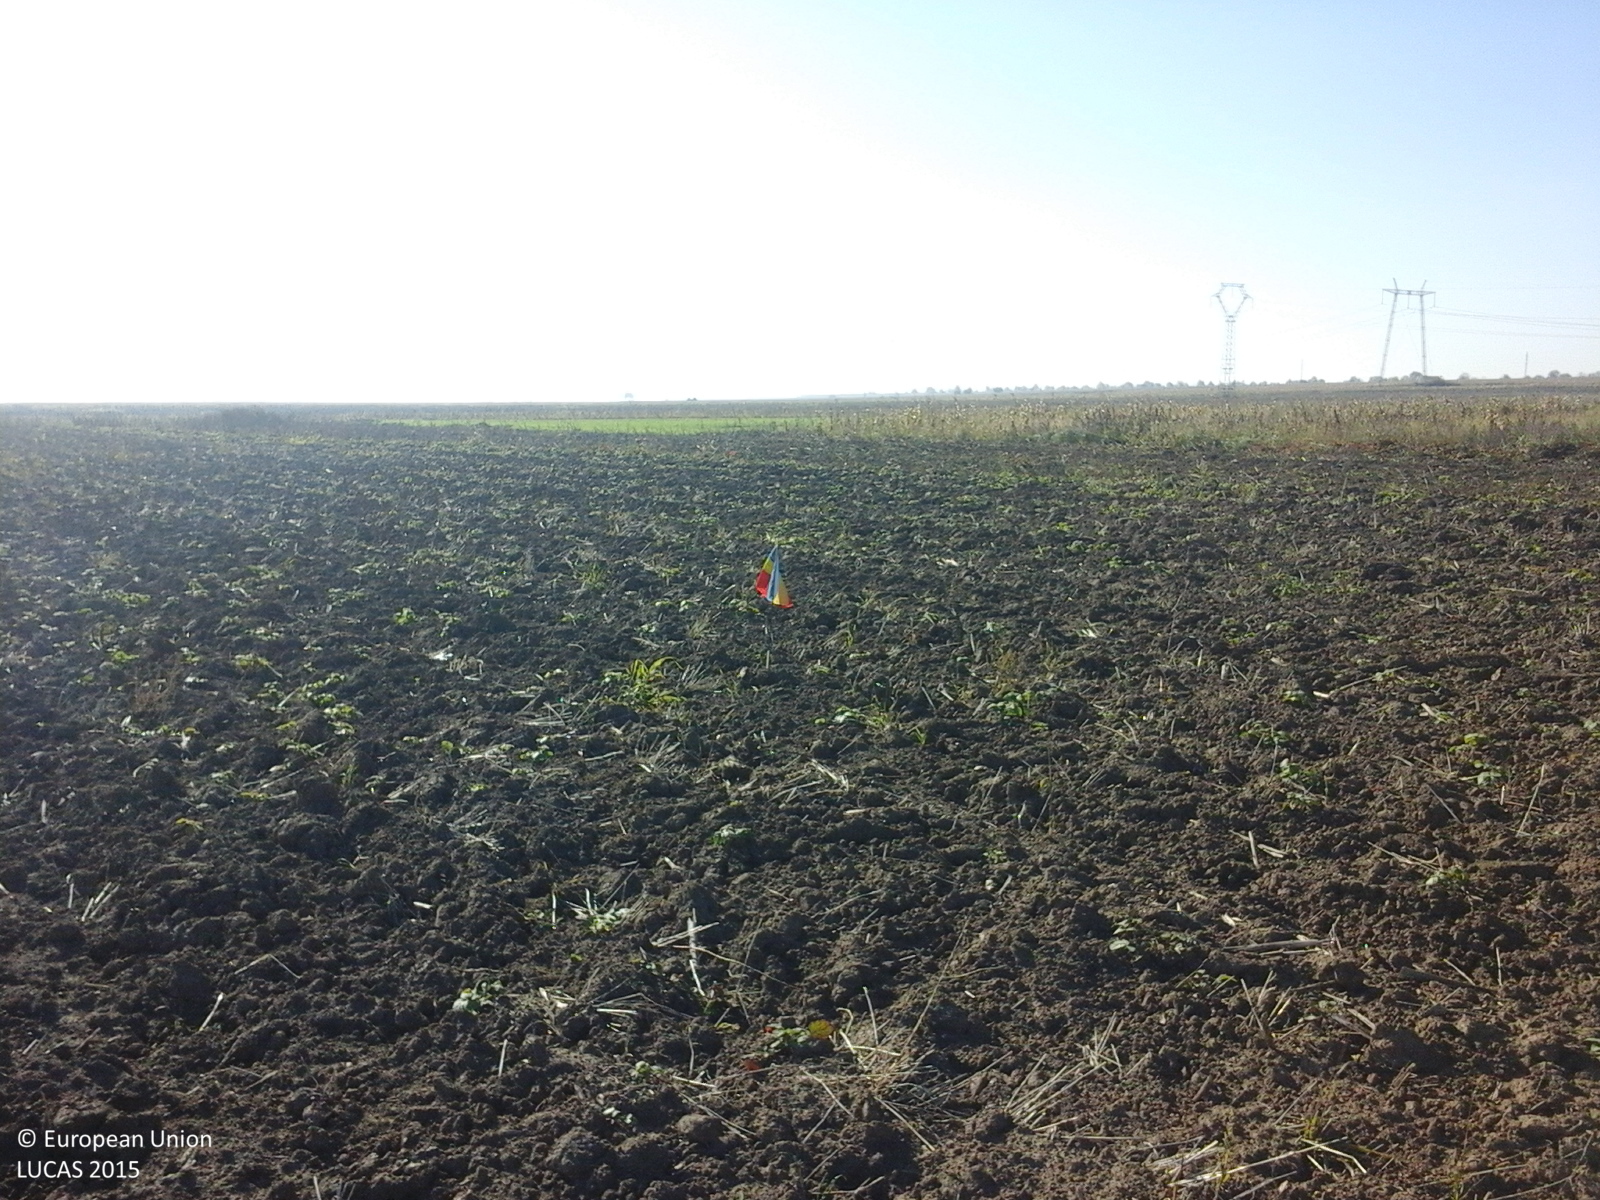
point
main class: Cropland
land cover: Common wheat
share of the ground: < 10 %
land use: Agriculture (excluding fallow land and kitchen gardens)
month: October
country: RO
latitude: 45.9442
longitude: 27.1622
